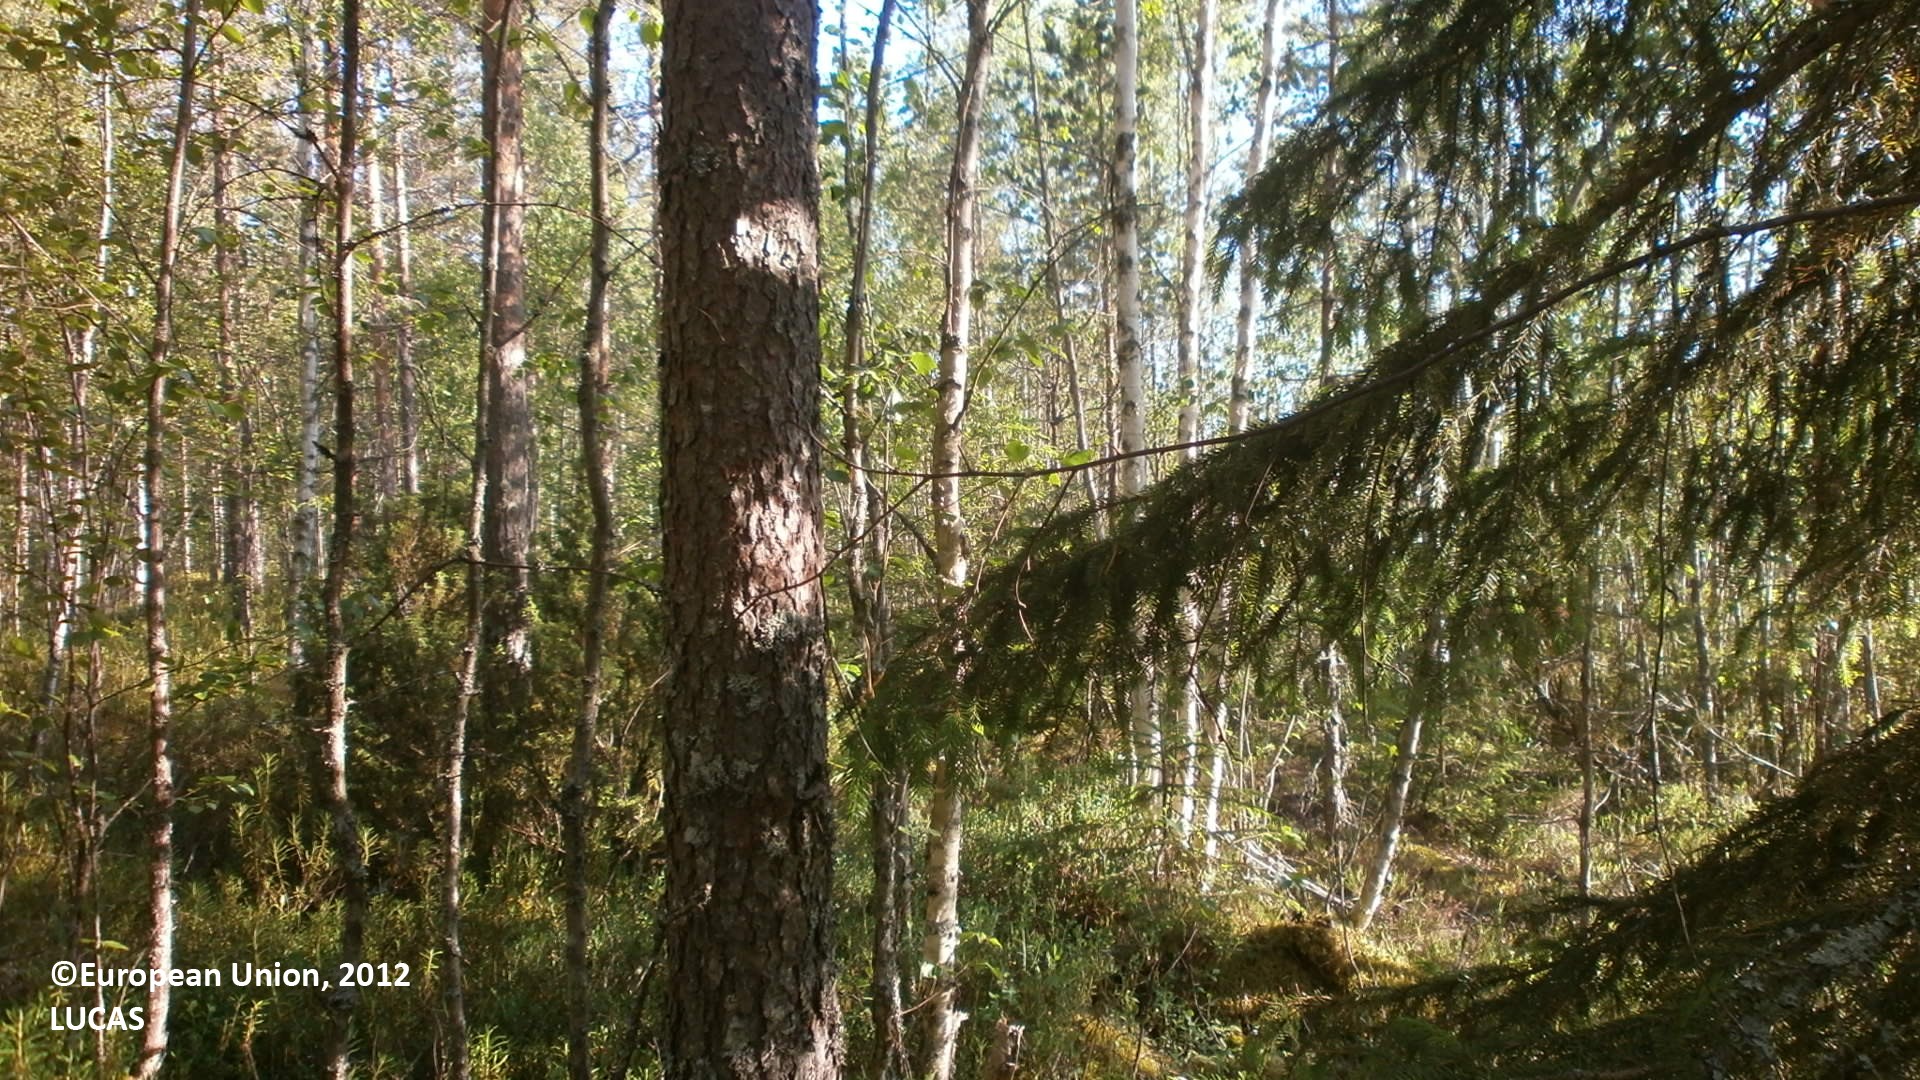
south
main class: Woodland
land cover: Pine dominated mixed woodland
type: boreal forest
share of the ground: > 75 %
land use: Forestry
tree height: > 5 m
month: July
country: FI
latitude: 64.0372
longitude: 24.9258
